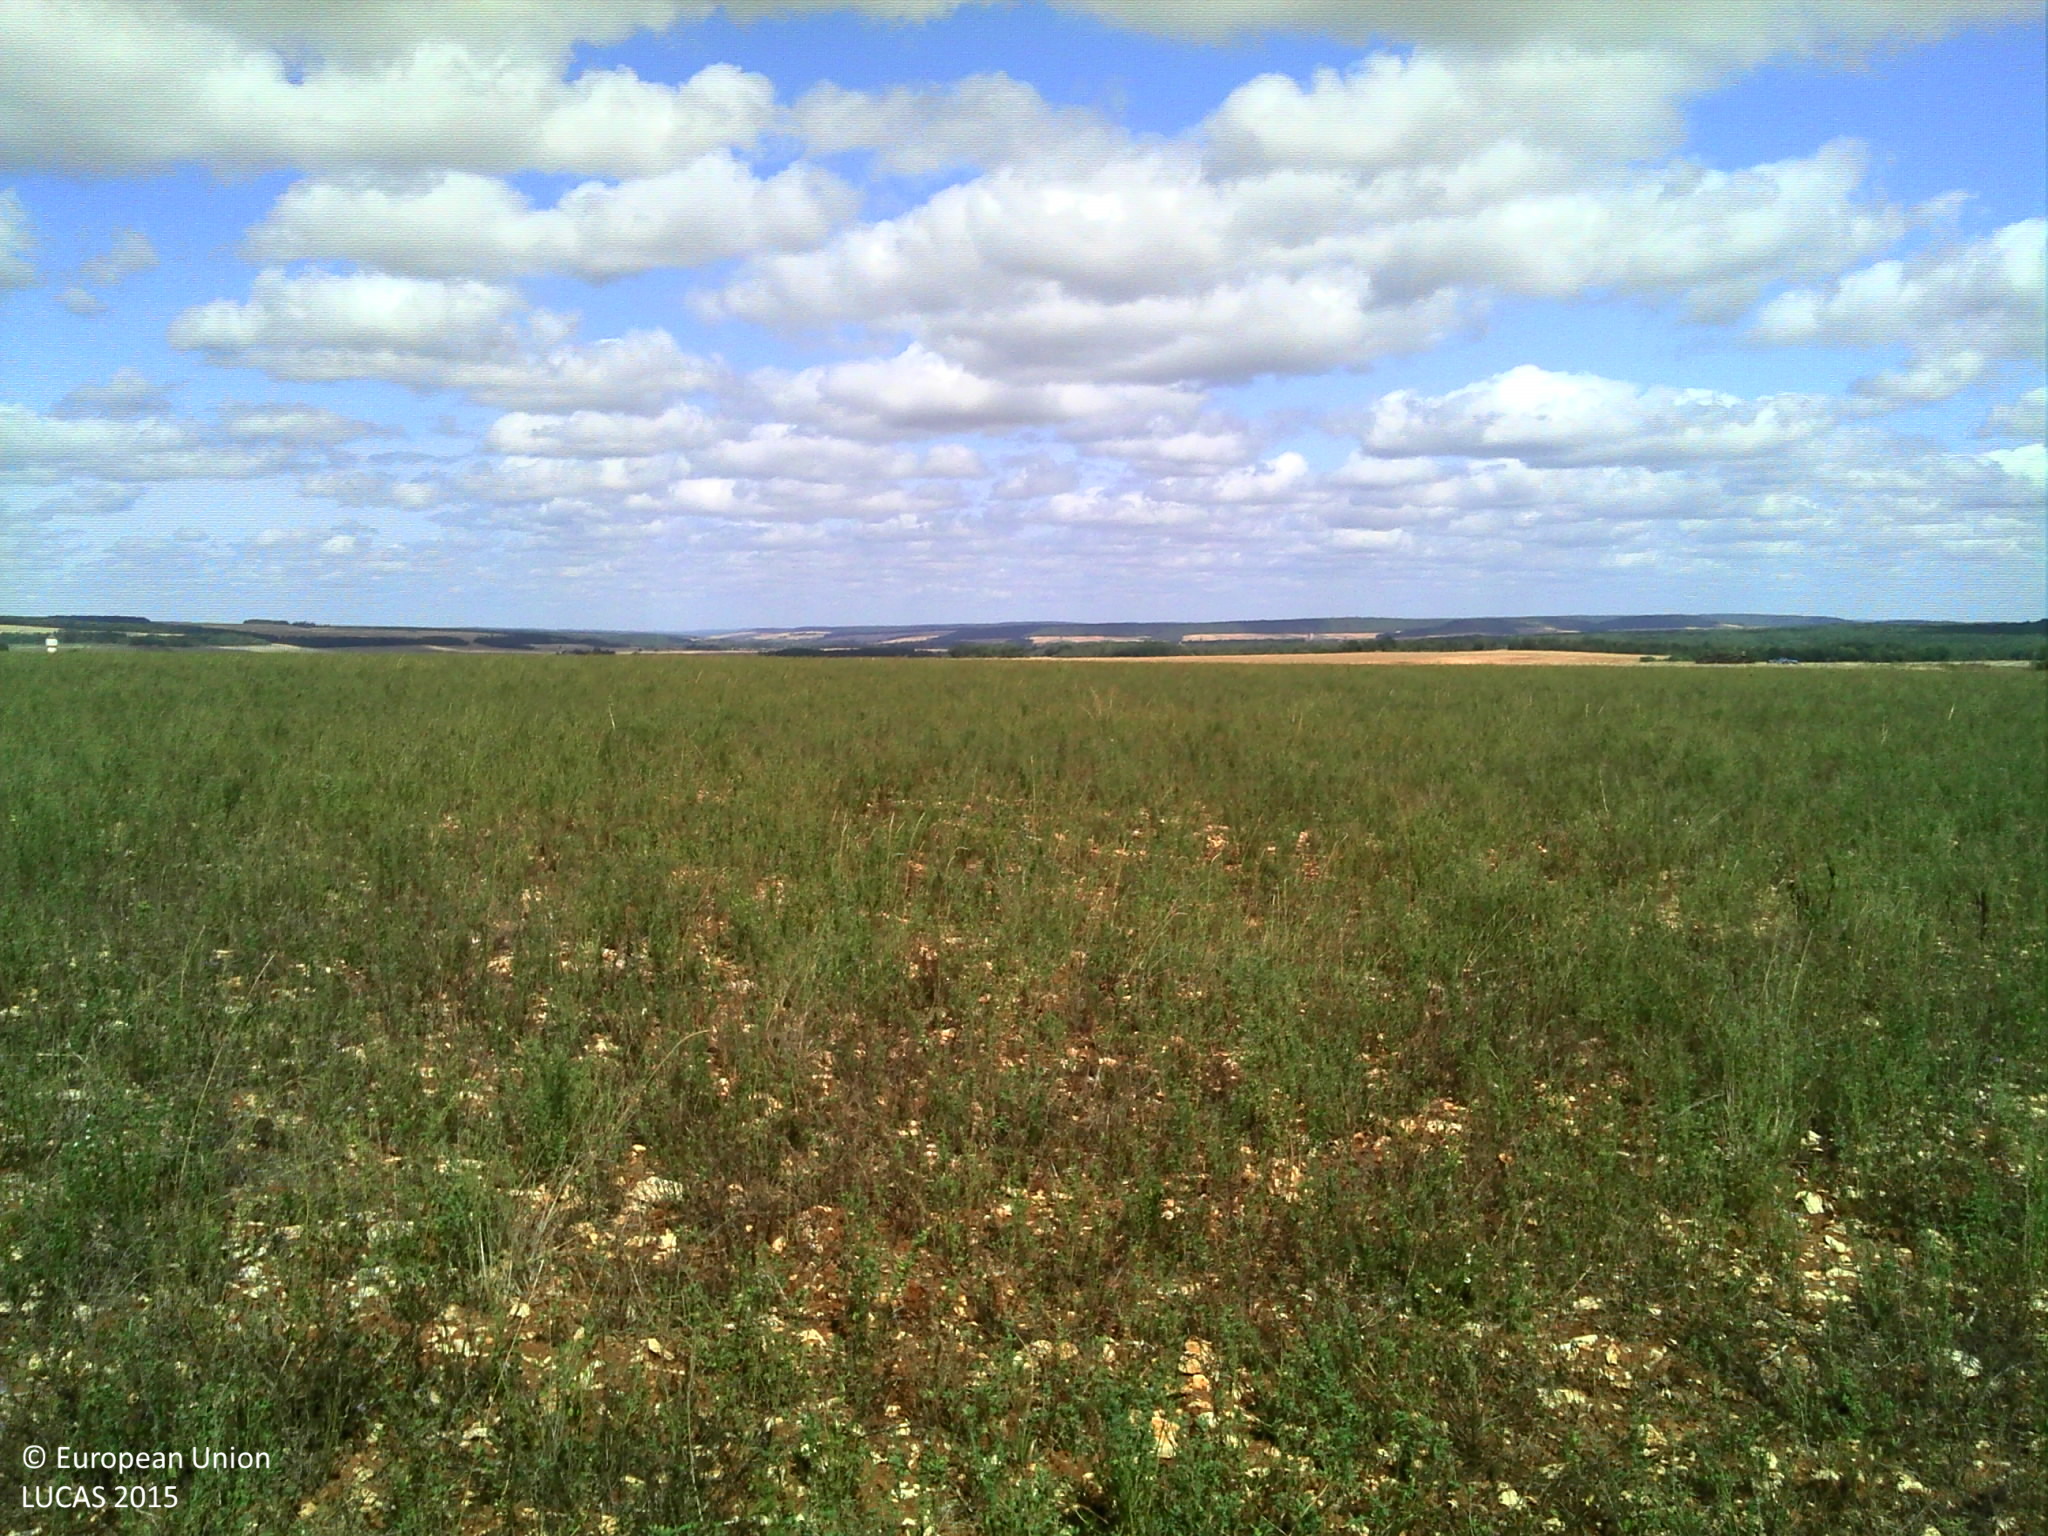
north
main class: Cropland
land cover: Lucerne
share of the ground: > 75 %
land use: Agriculture (excluding fallow land and kitchen gardens)
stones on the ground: 10 - 25 %
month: August
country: FR
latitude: 47.8831
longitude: 4.7703
